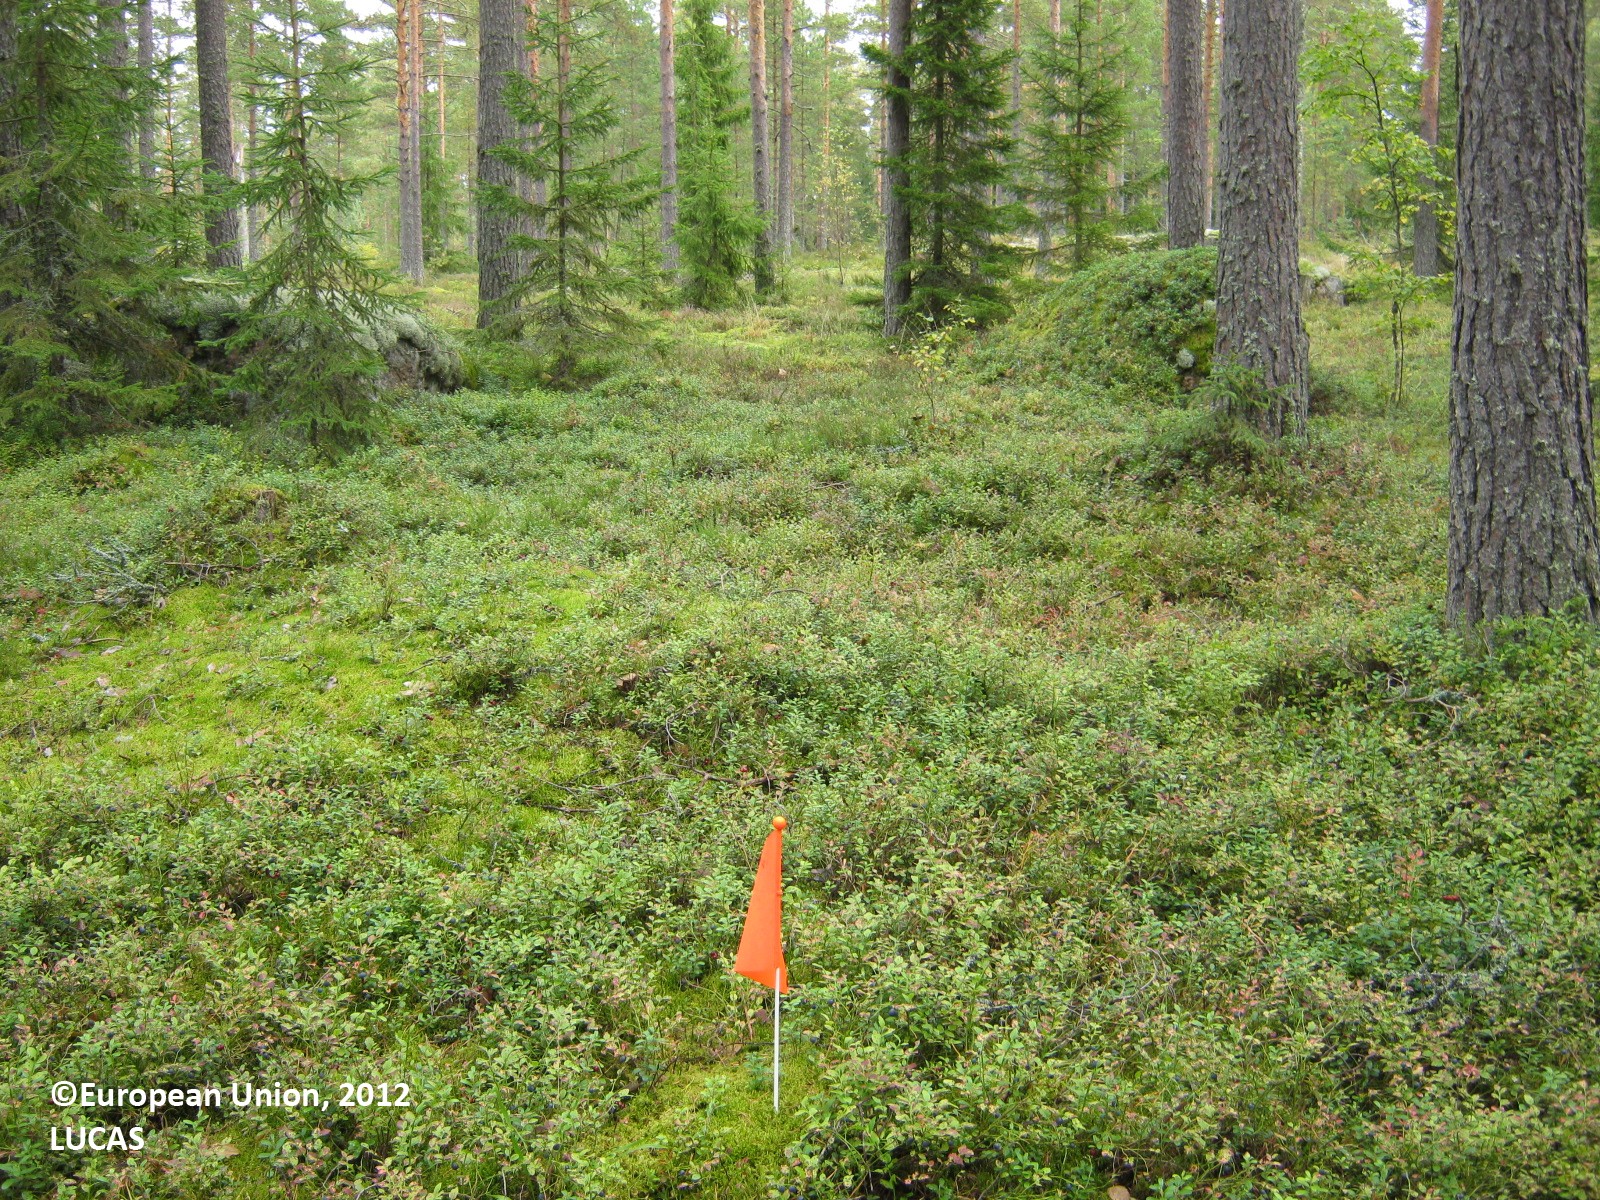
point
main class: Woodland
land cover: Other coniferous woodland
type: boreal forest
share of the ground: 50 - 75 %
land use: Forestry
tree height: > 5 m
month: September
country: FI
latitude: 60.6415
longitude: 27.6906
